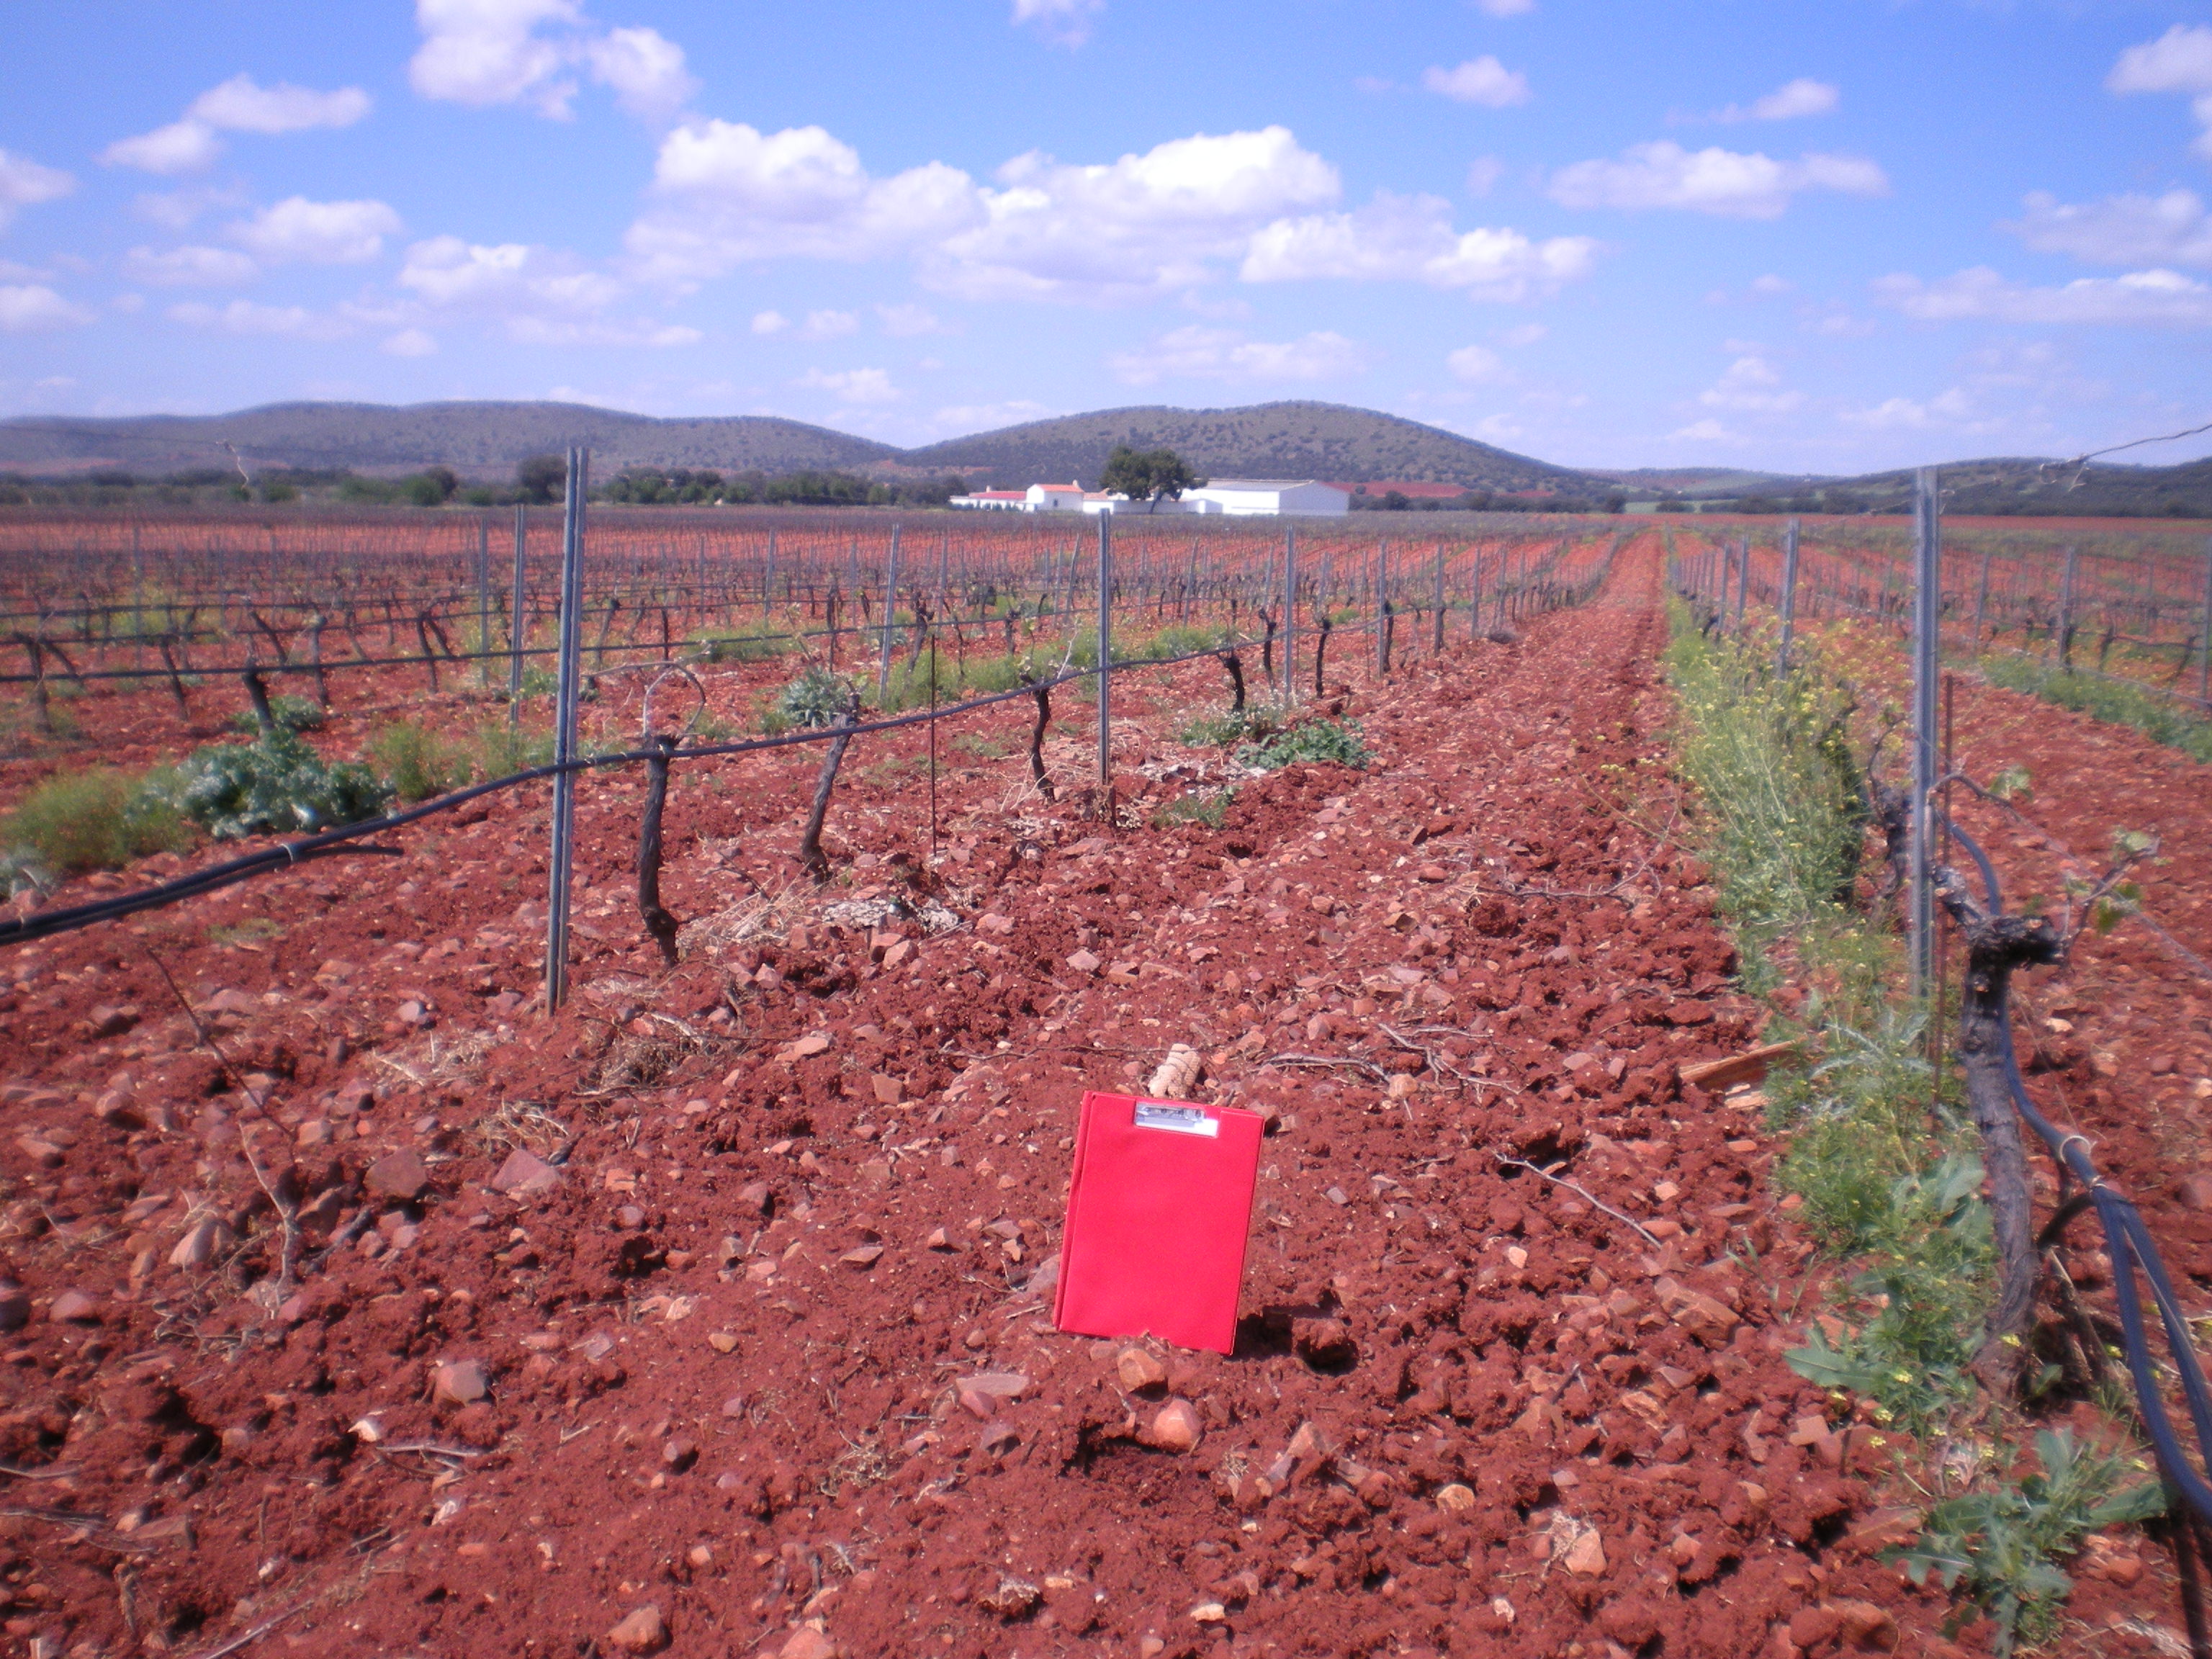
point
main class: Cropland
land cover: Vineyards
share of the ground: < 10 %
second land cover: Spontaneously vegetated surfaces
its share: < 10 %
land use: Agriculture (excluding fallow land and kitchen gardens)
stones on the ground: 10 - 25 %
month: April
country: ES
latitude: 38.7179
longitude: -3.5490
